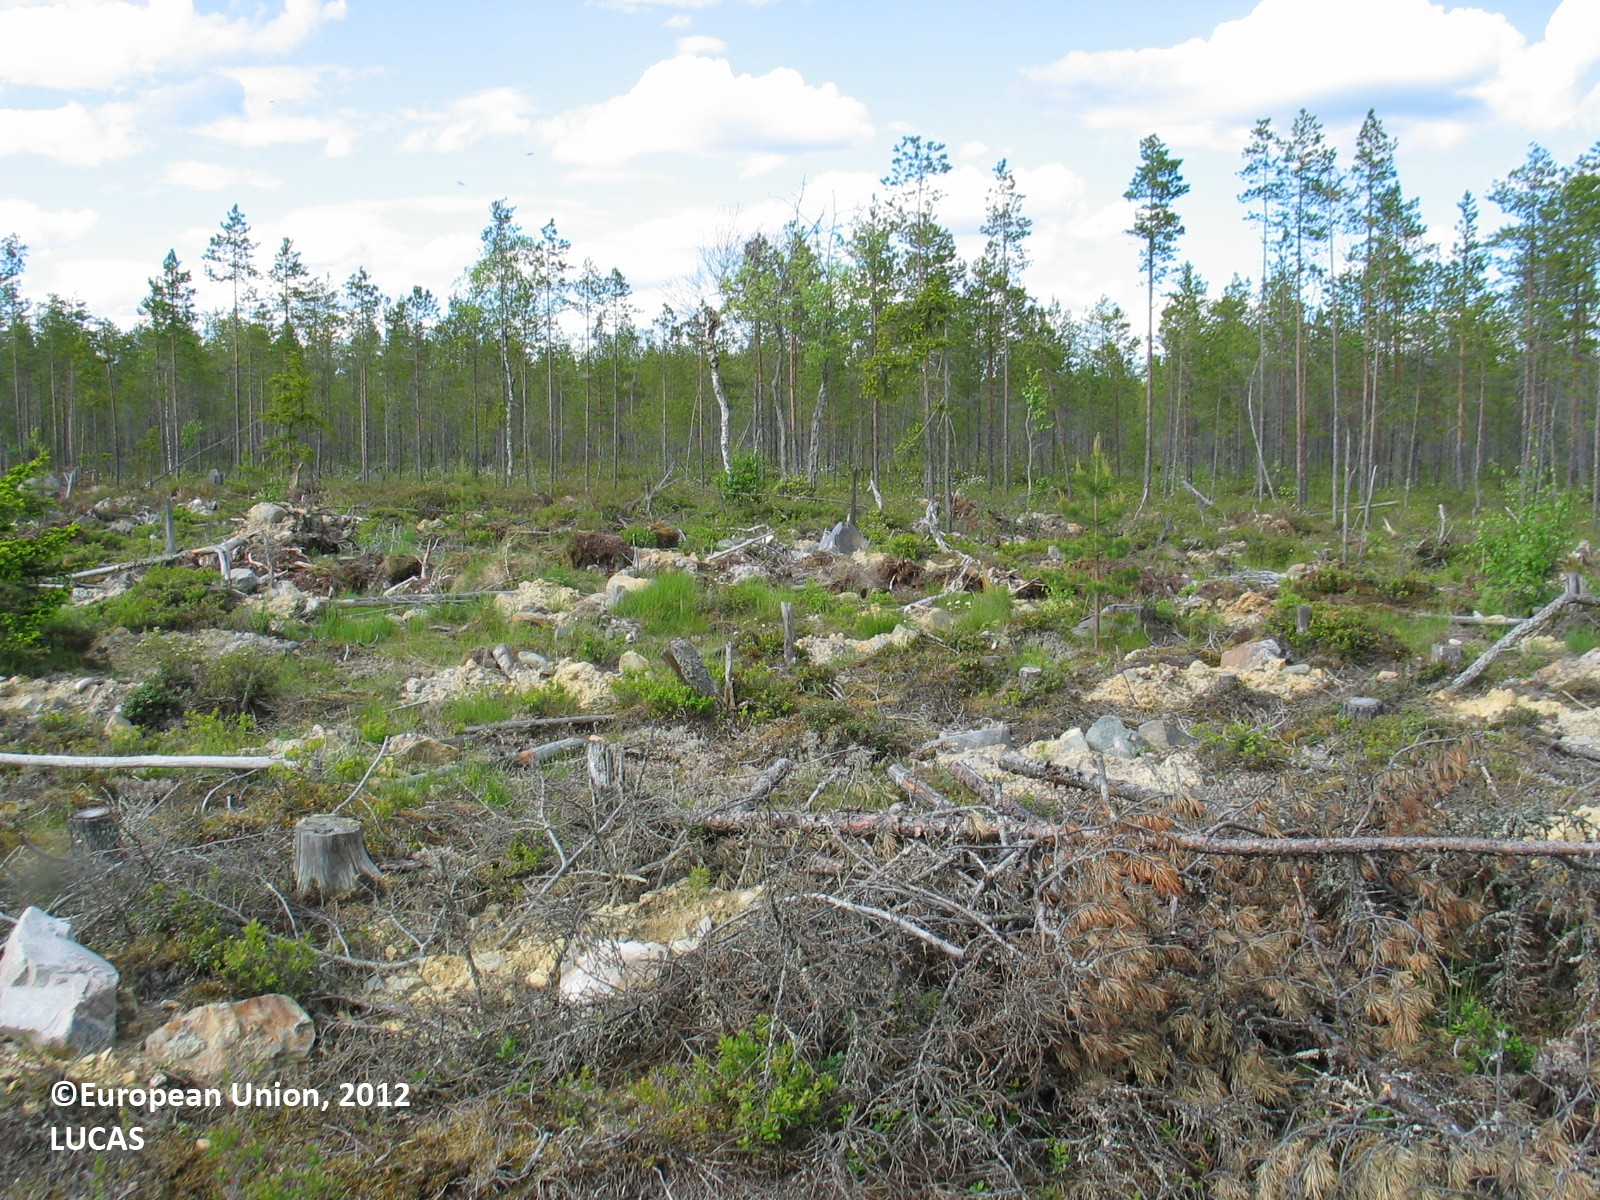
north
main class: Shrubland
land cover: Shrubland without tree cover
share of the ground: 25 - 50 %
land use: Forestry
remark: Clear cut
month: June
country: FI
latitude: 64.8955
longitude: 26.5236
